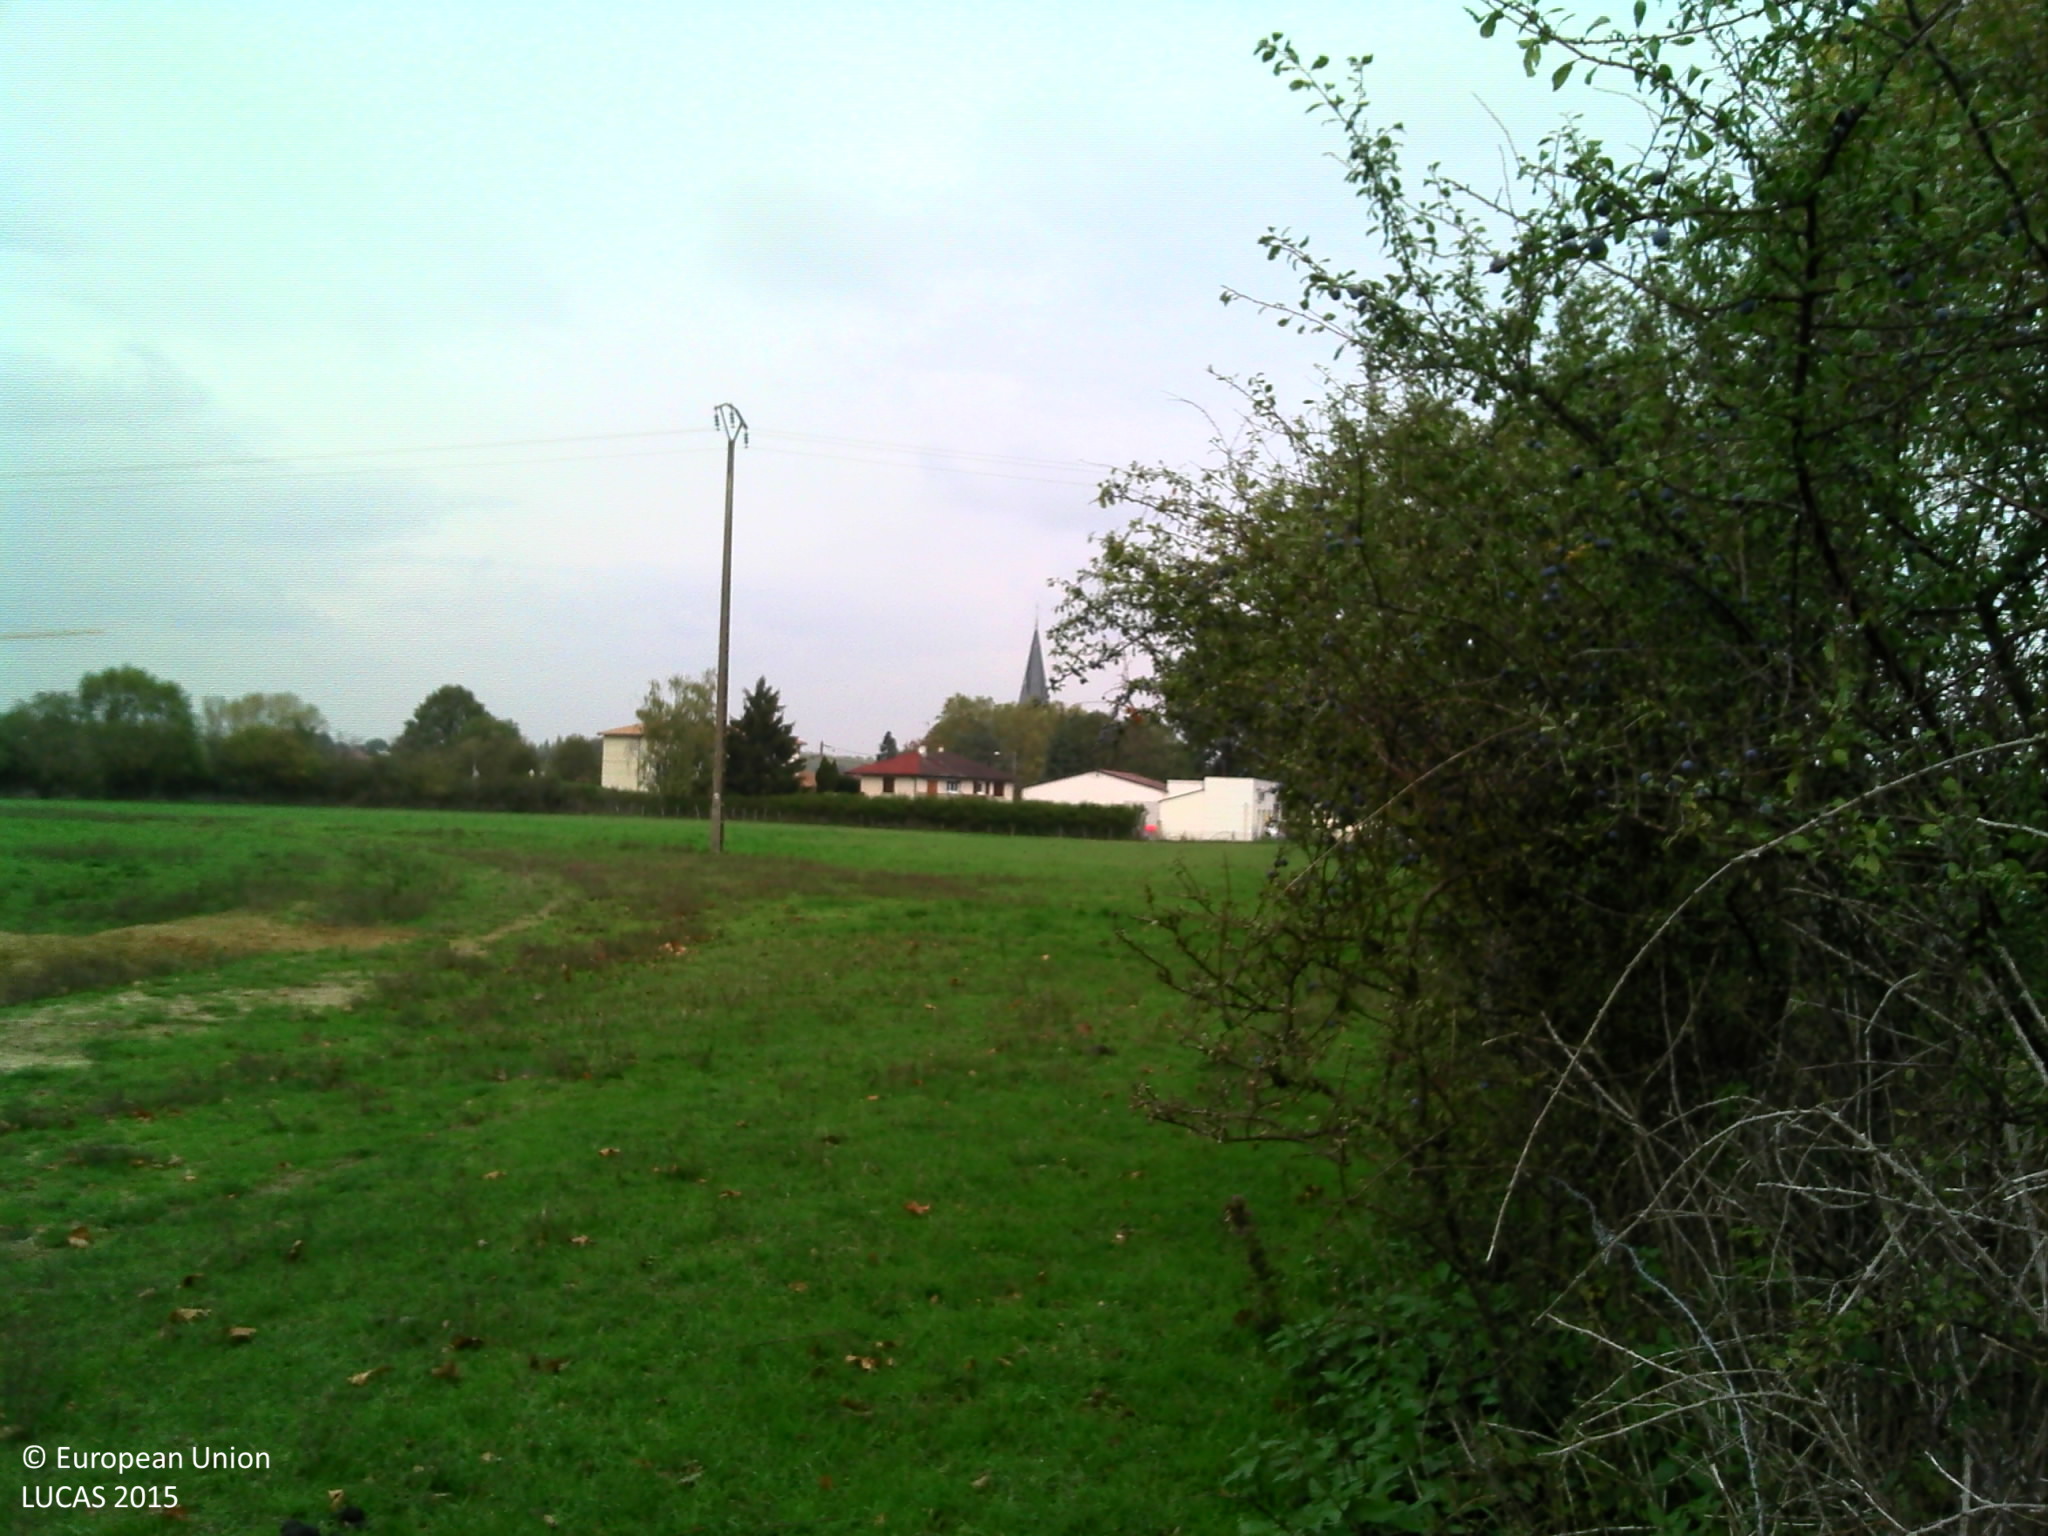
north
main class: Grassland
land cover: Grassland without tree/shrub cover
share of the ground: > 75 %
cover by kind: herbaceous plants 100 %
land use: Agriculture (excluding fallow land and kitchen gardens)
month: October
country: FR
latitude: 46.0670
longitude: 4.8963
